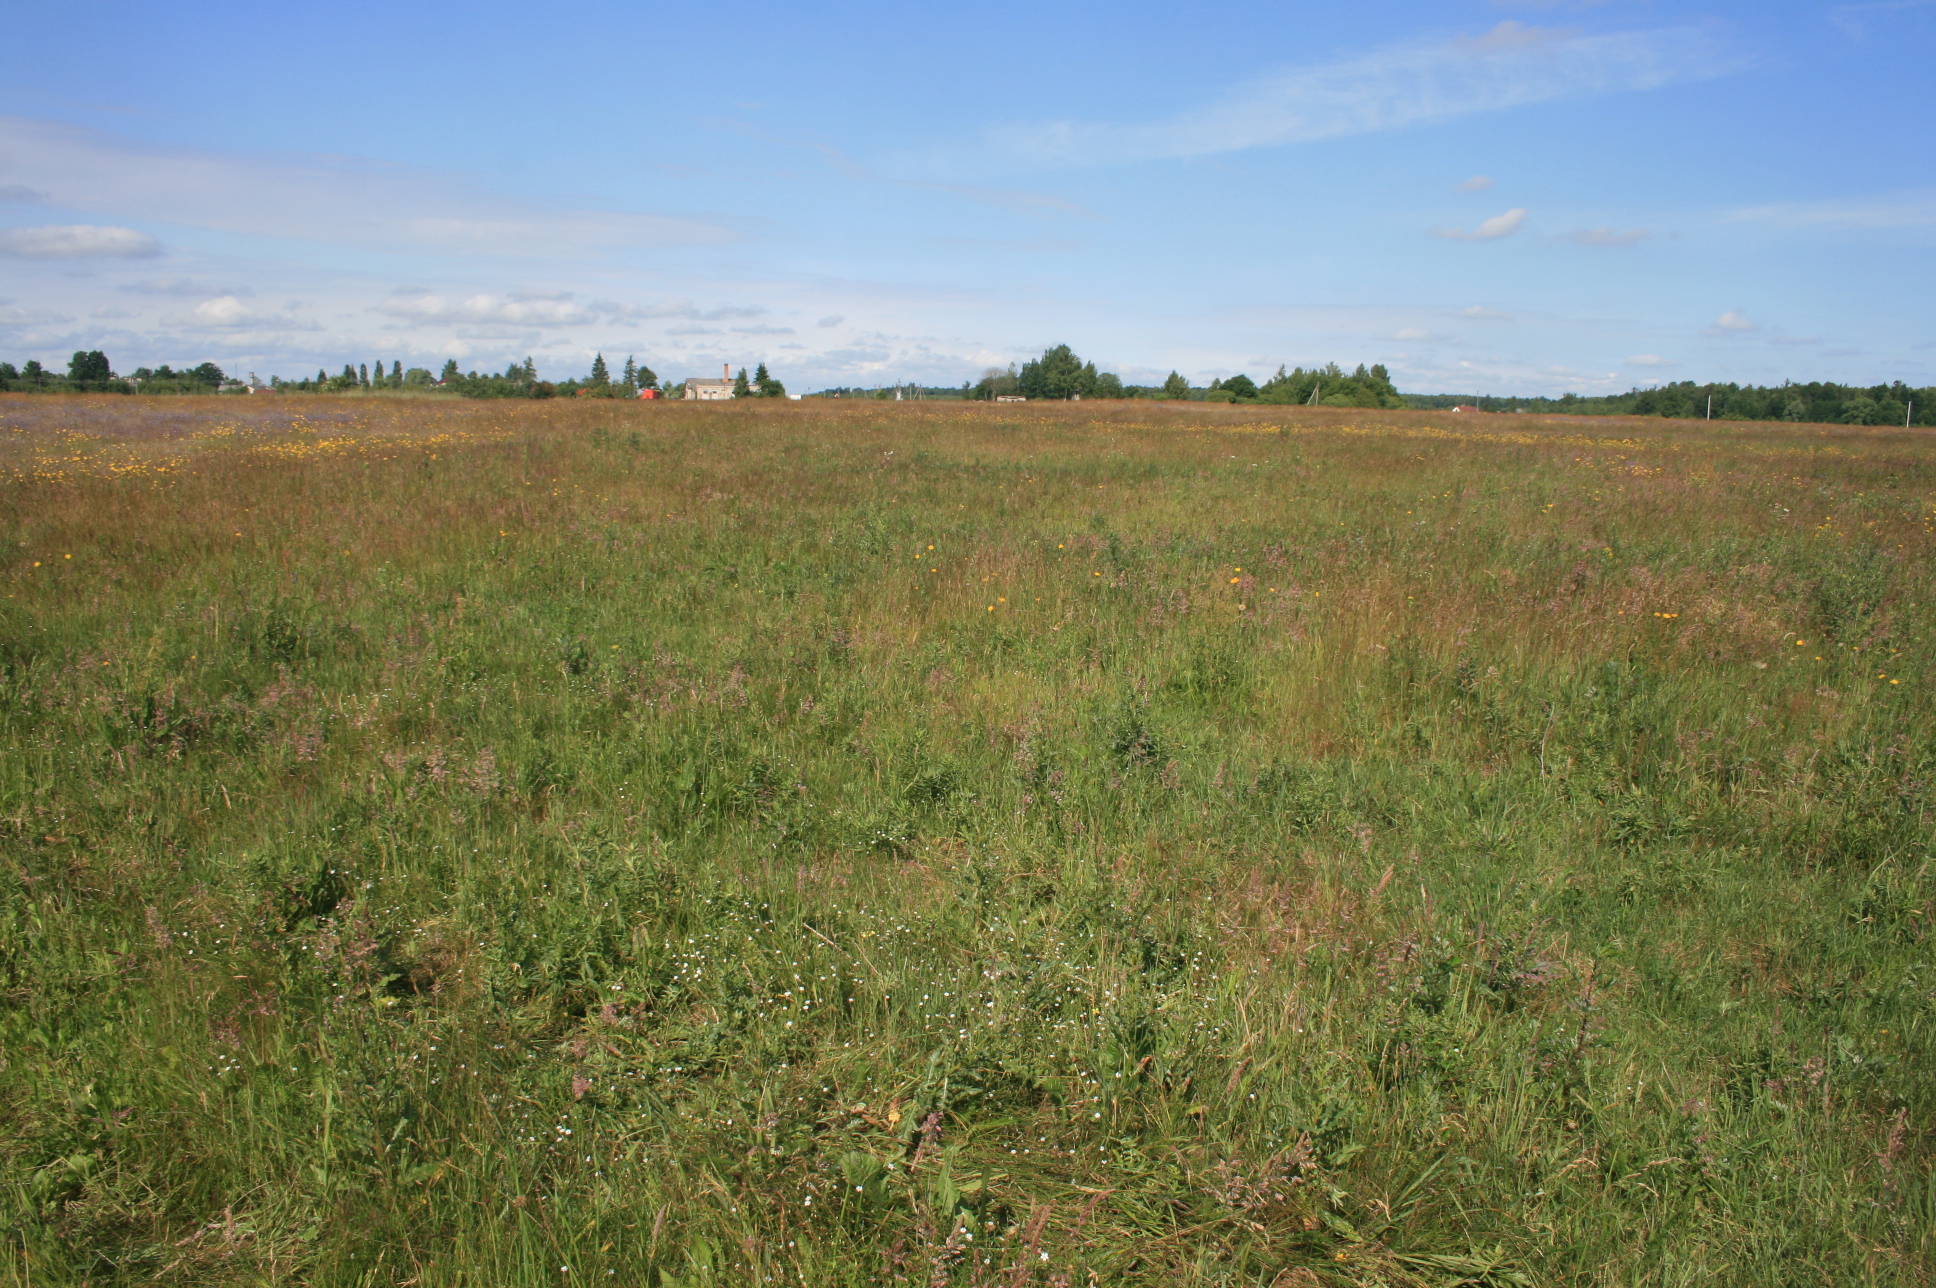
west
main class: Grassland
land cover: Grassland without tree/shrub cover
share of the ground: > 75 %
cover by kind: herbaceous plants 100 %
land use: Agriculture (excluding fallow land and kitchen gardens)
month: June
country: LT
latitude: 55.2320
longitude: 21.7009
